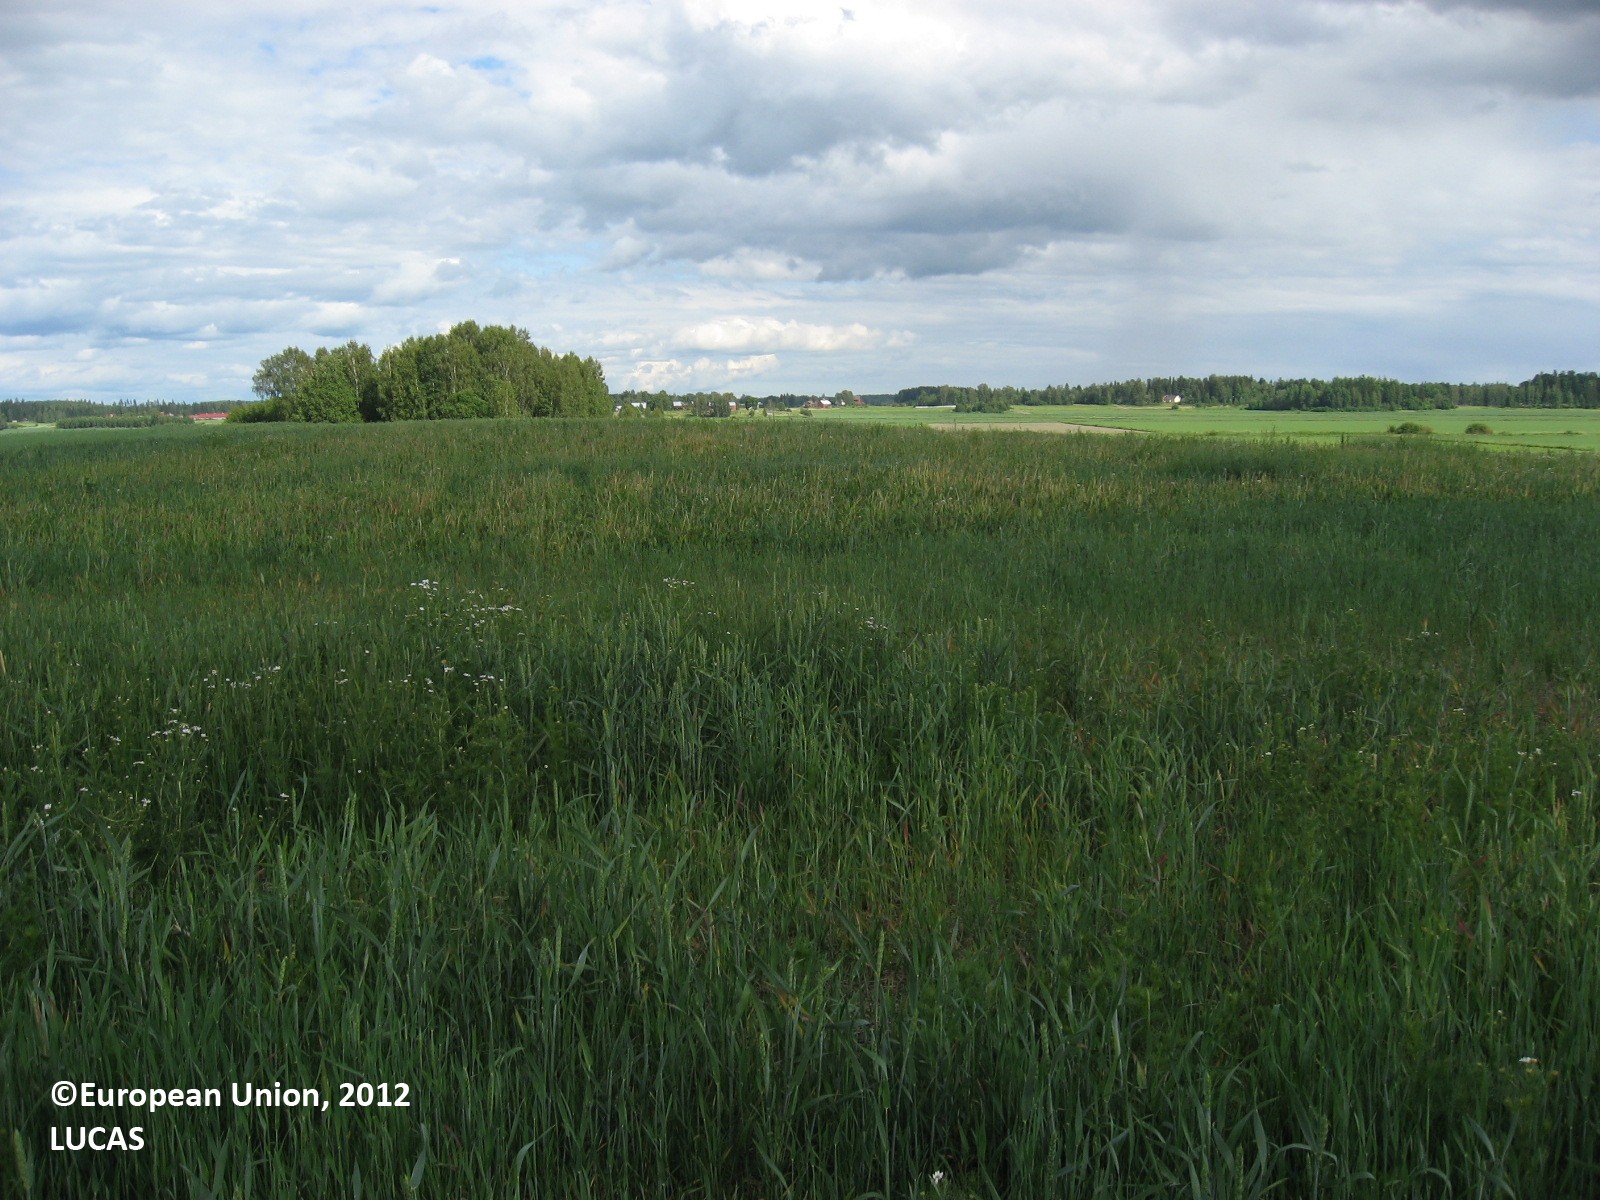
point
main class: Cropland
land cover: Common wheat
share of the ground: > 75 %
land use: Agriculture (excluding fallow land and kitchen gardens)
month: June
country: FI
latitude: 60.7358
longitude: 26.4560
